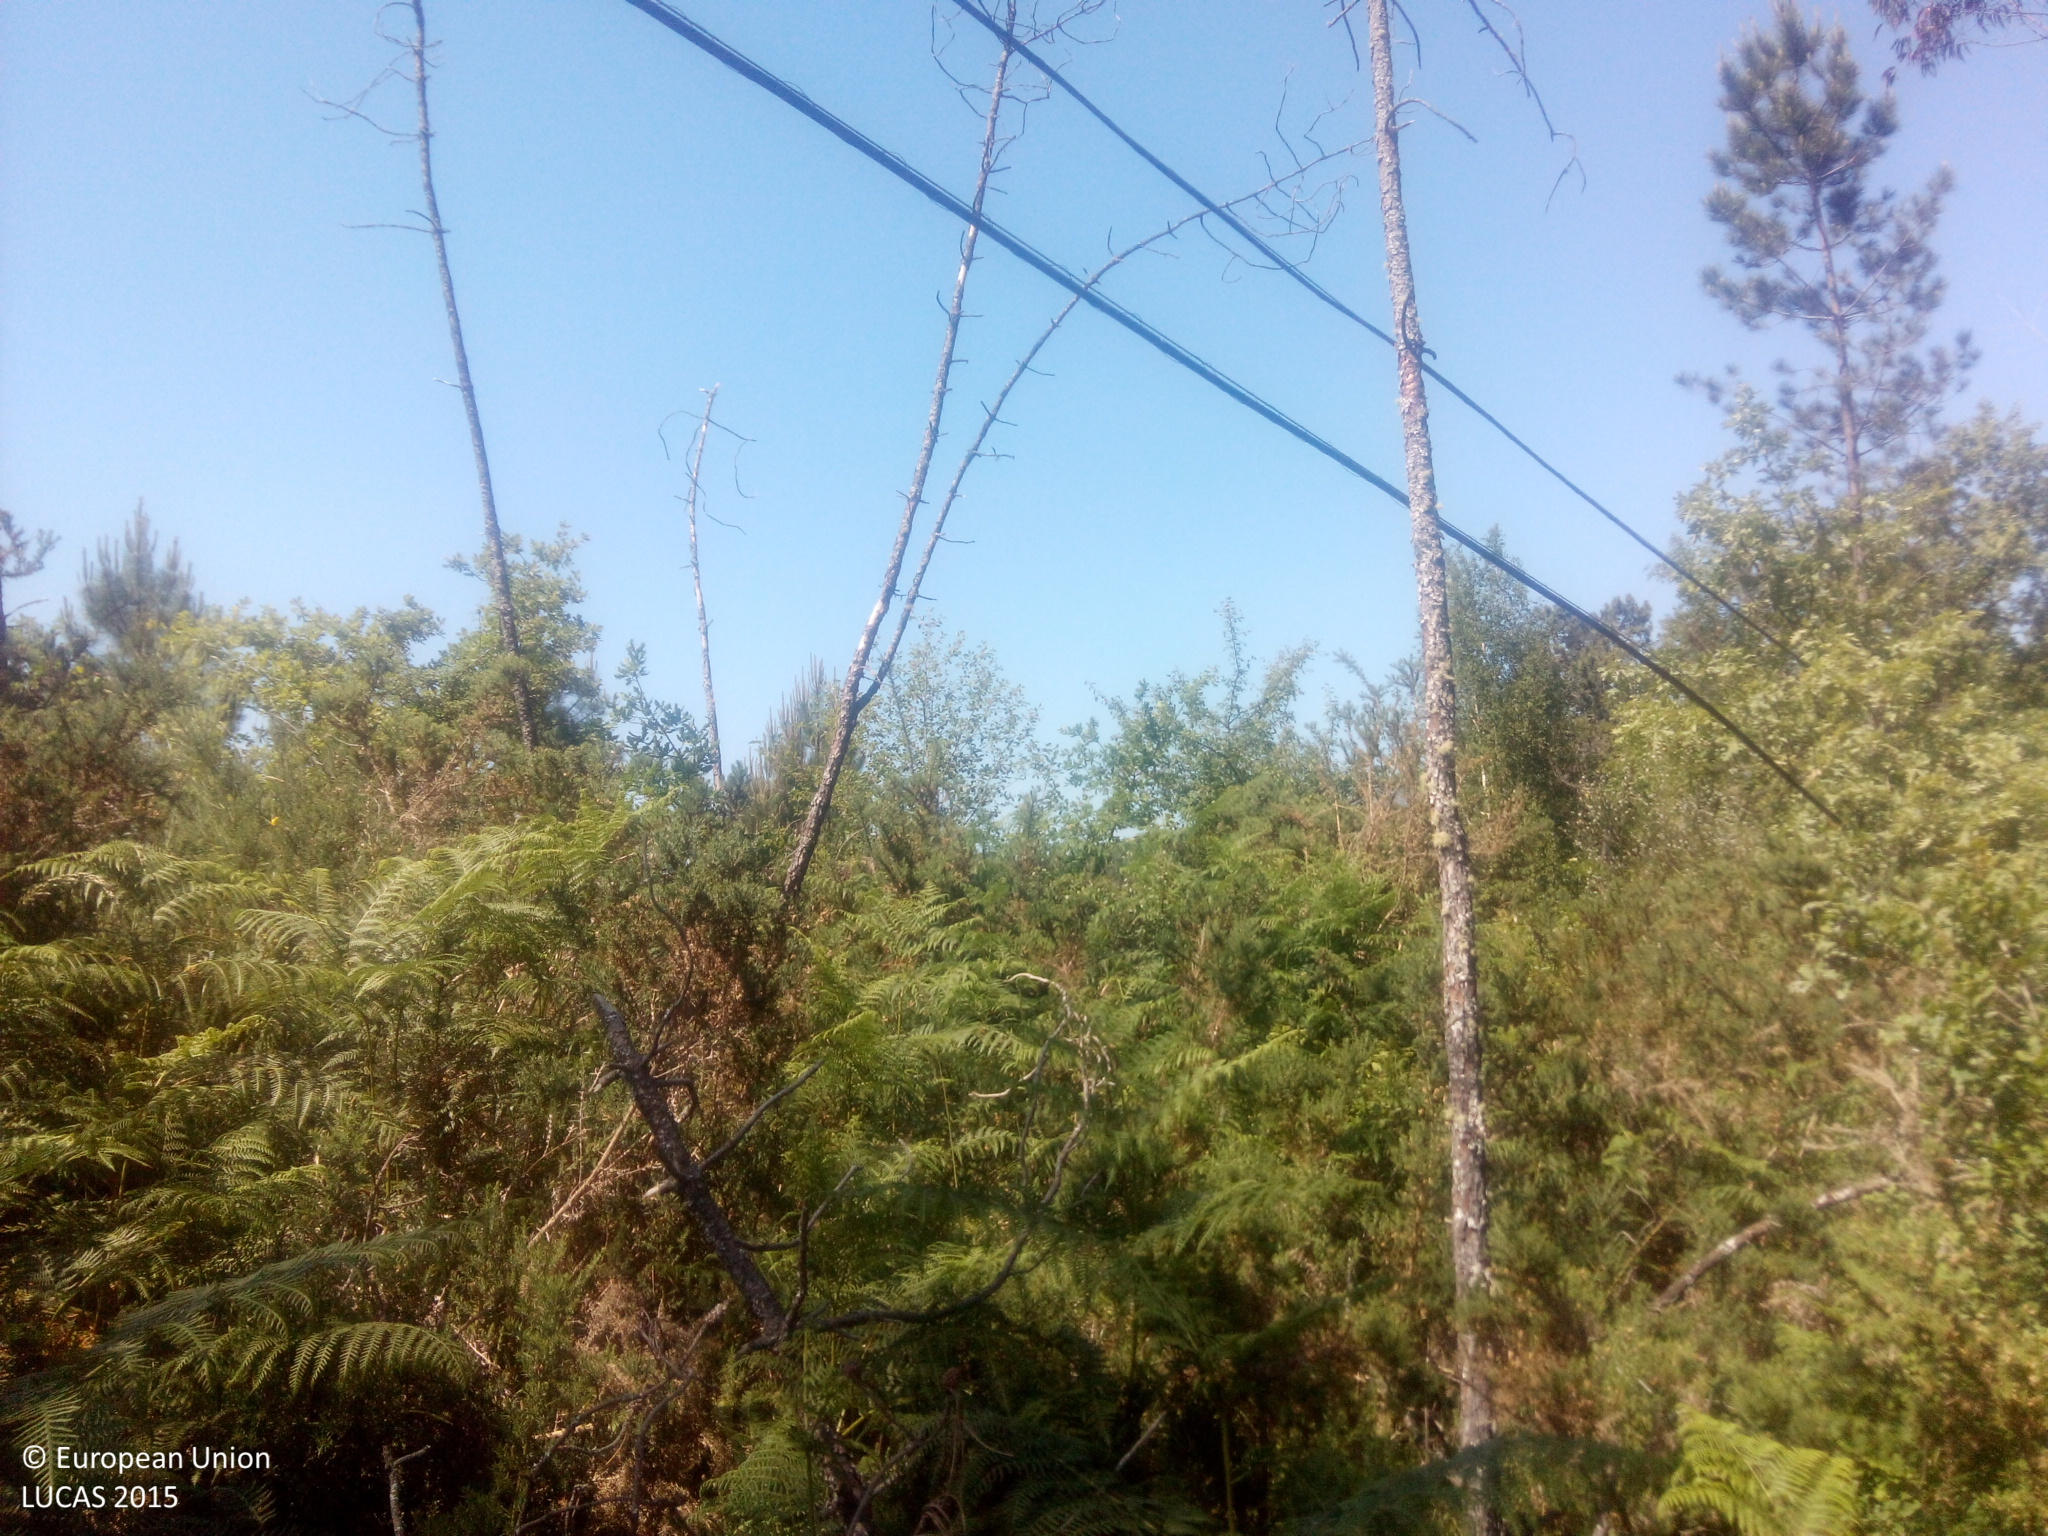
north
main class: Woodland
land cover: Pine dominated coniferous woodland
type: exotic forest
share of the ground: > 75 %
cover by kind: coniferous forest trees 75 %, shrubs 25 %
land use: Forestry
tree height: > 5 m
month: June
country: ES
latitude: 42.2087
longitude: -8.2928
